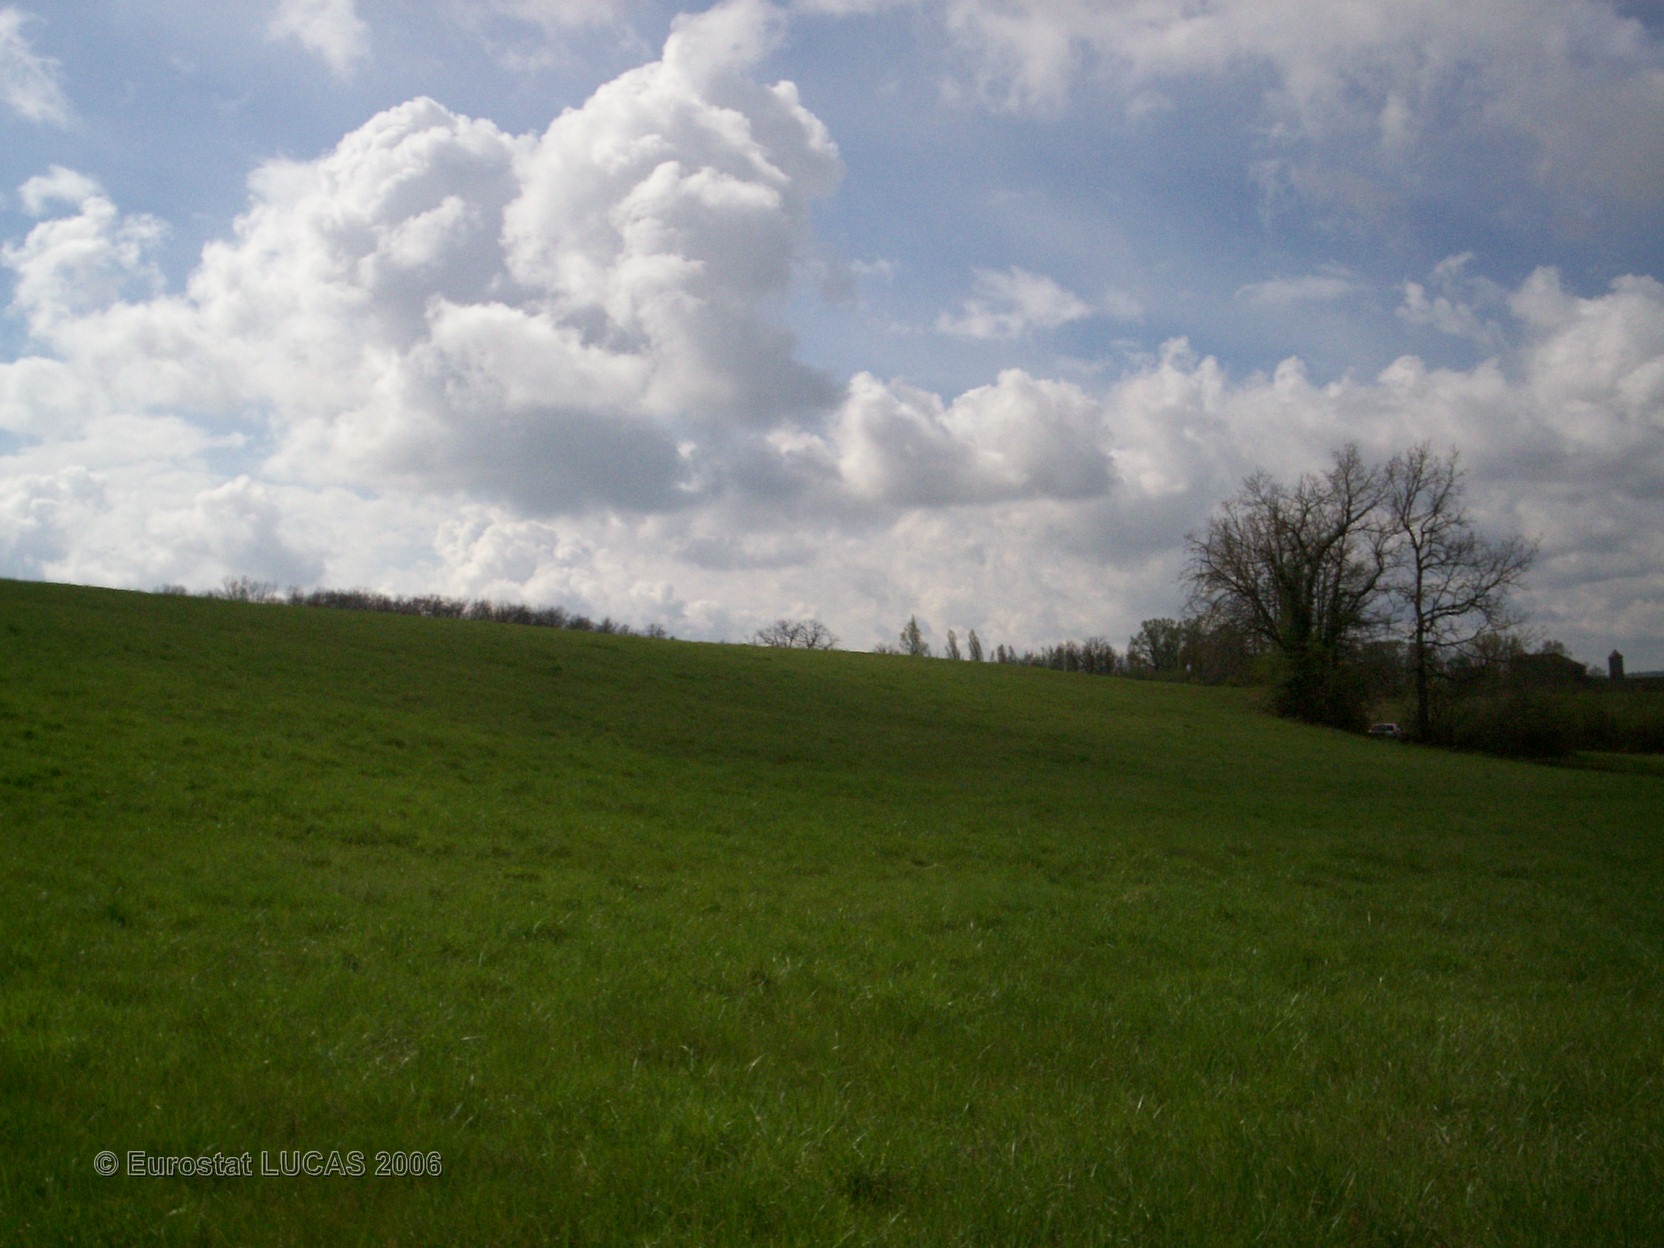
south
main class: Grassland
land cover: Grassland without tree/shrub cover
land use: Agriculture (excluding fallow land and kitchen gardens)
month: April
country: FR
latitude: 43.9701
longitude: 0.1332
